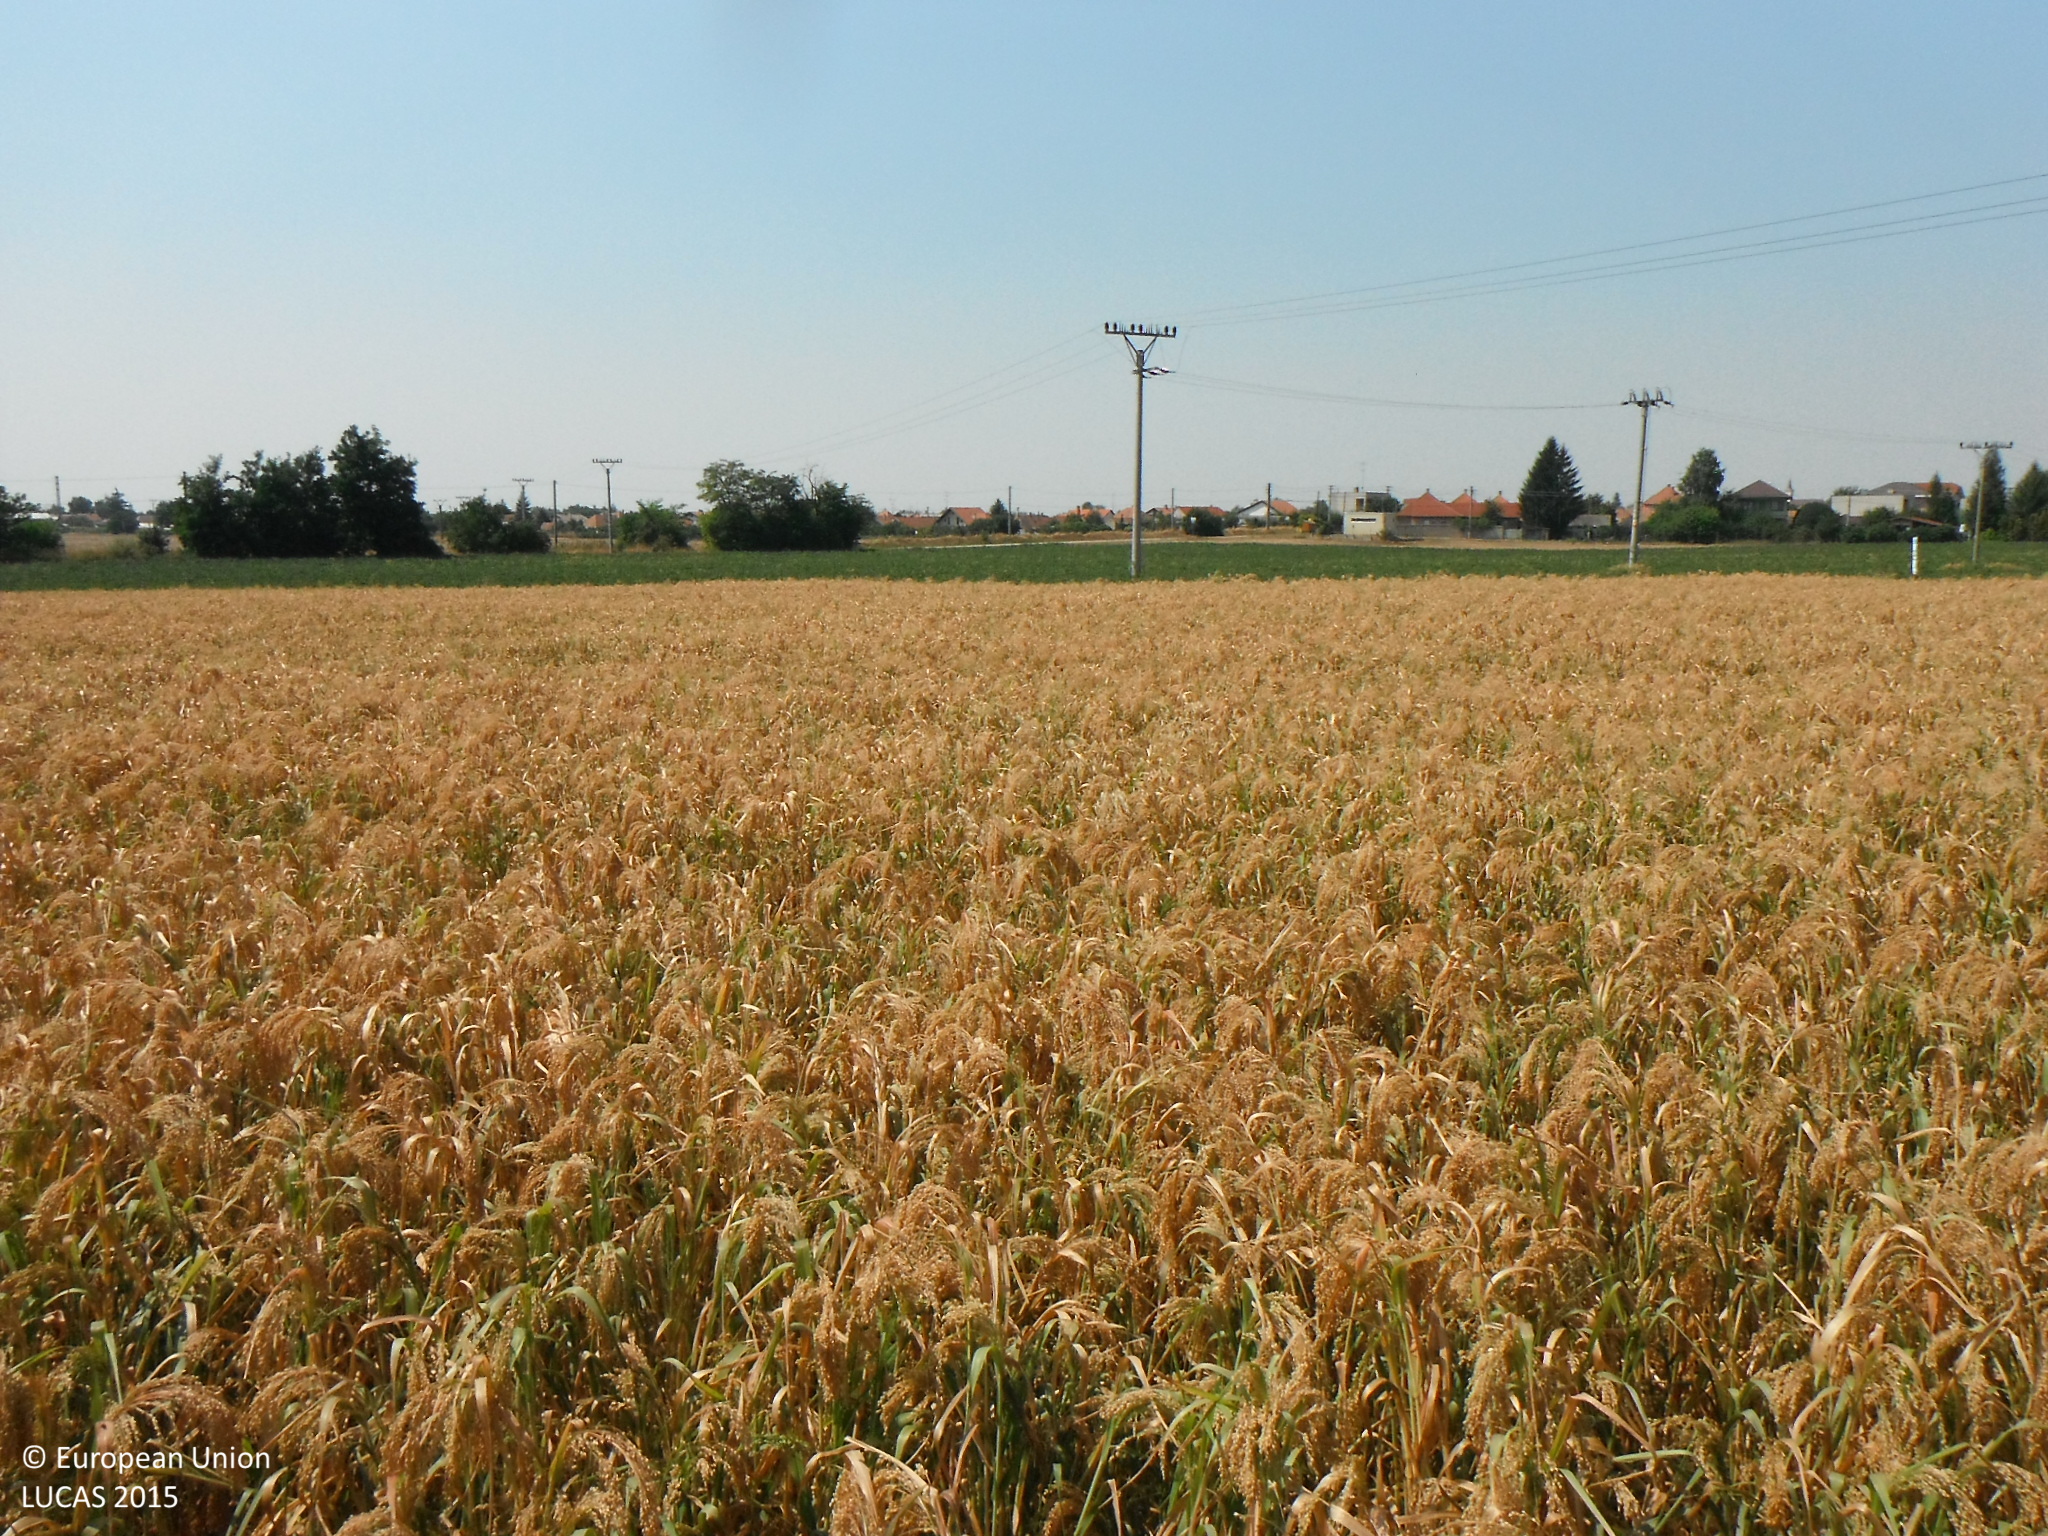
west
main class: Cropland
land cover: Maize
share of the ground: > 75 %
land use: Agriculture (excluding fallow land and kitchen gardens)
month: August
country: SK
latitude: 47.9840
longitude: 18.2808
